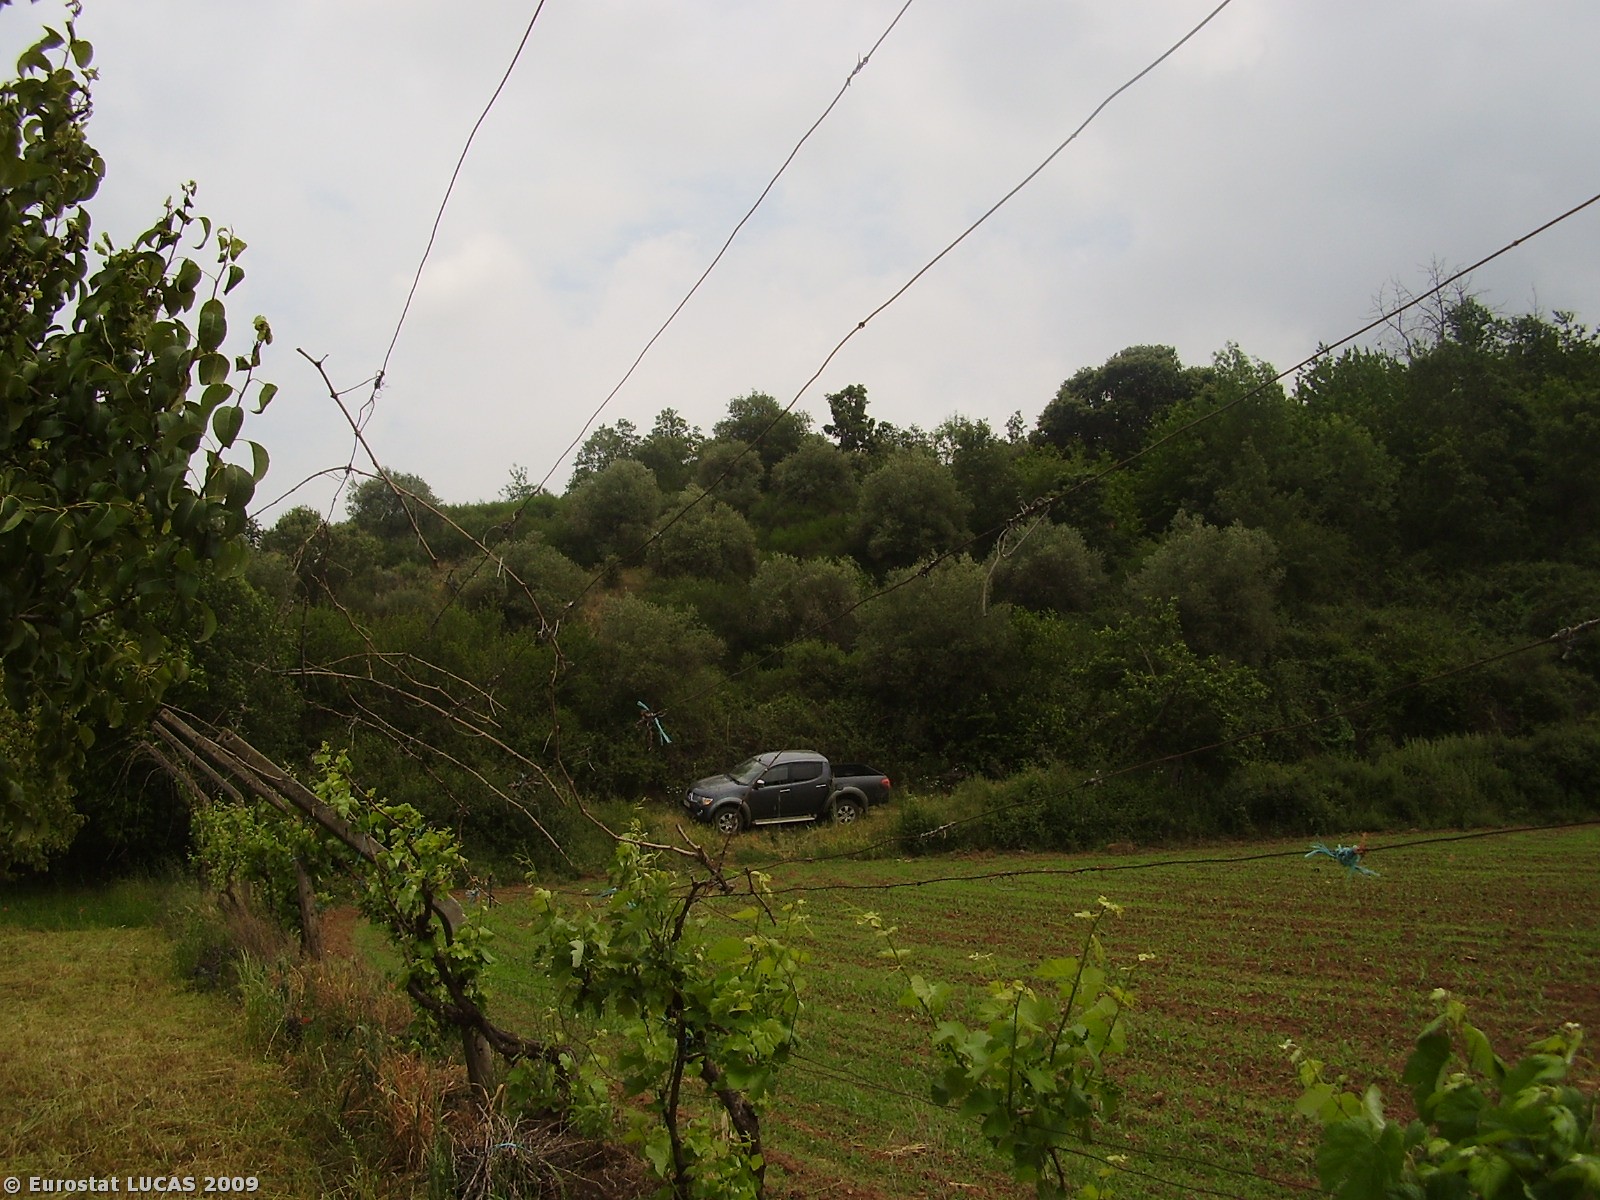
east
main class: Cropland
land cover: Mixed cereals for fodder
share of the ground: > 75 %
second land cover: Pear fruit
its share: < 10 %
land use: Agriculture (excluding fallow land and kitchen gardens)
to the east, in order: Mixed cereals for fodder; Pear fruit; Managed hedges; Grass margins; Dry stone walls; Tracks; Ditches and canals; Shruby margins; Abandoned hedges; Temporary grasslands; Abandoned hedges; Tracks; Spontaneously vegetated surfaces; Ponds and wetlands; Abandoned hedges; Shruby margins; Mixed cereals for fodder; Broadleaved woodland; Abandoned hedges; Dry stone walls; Spontaneously vegetated surfaces
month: June
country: PT
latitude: 41.5596
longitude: -6.8628
